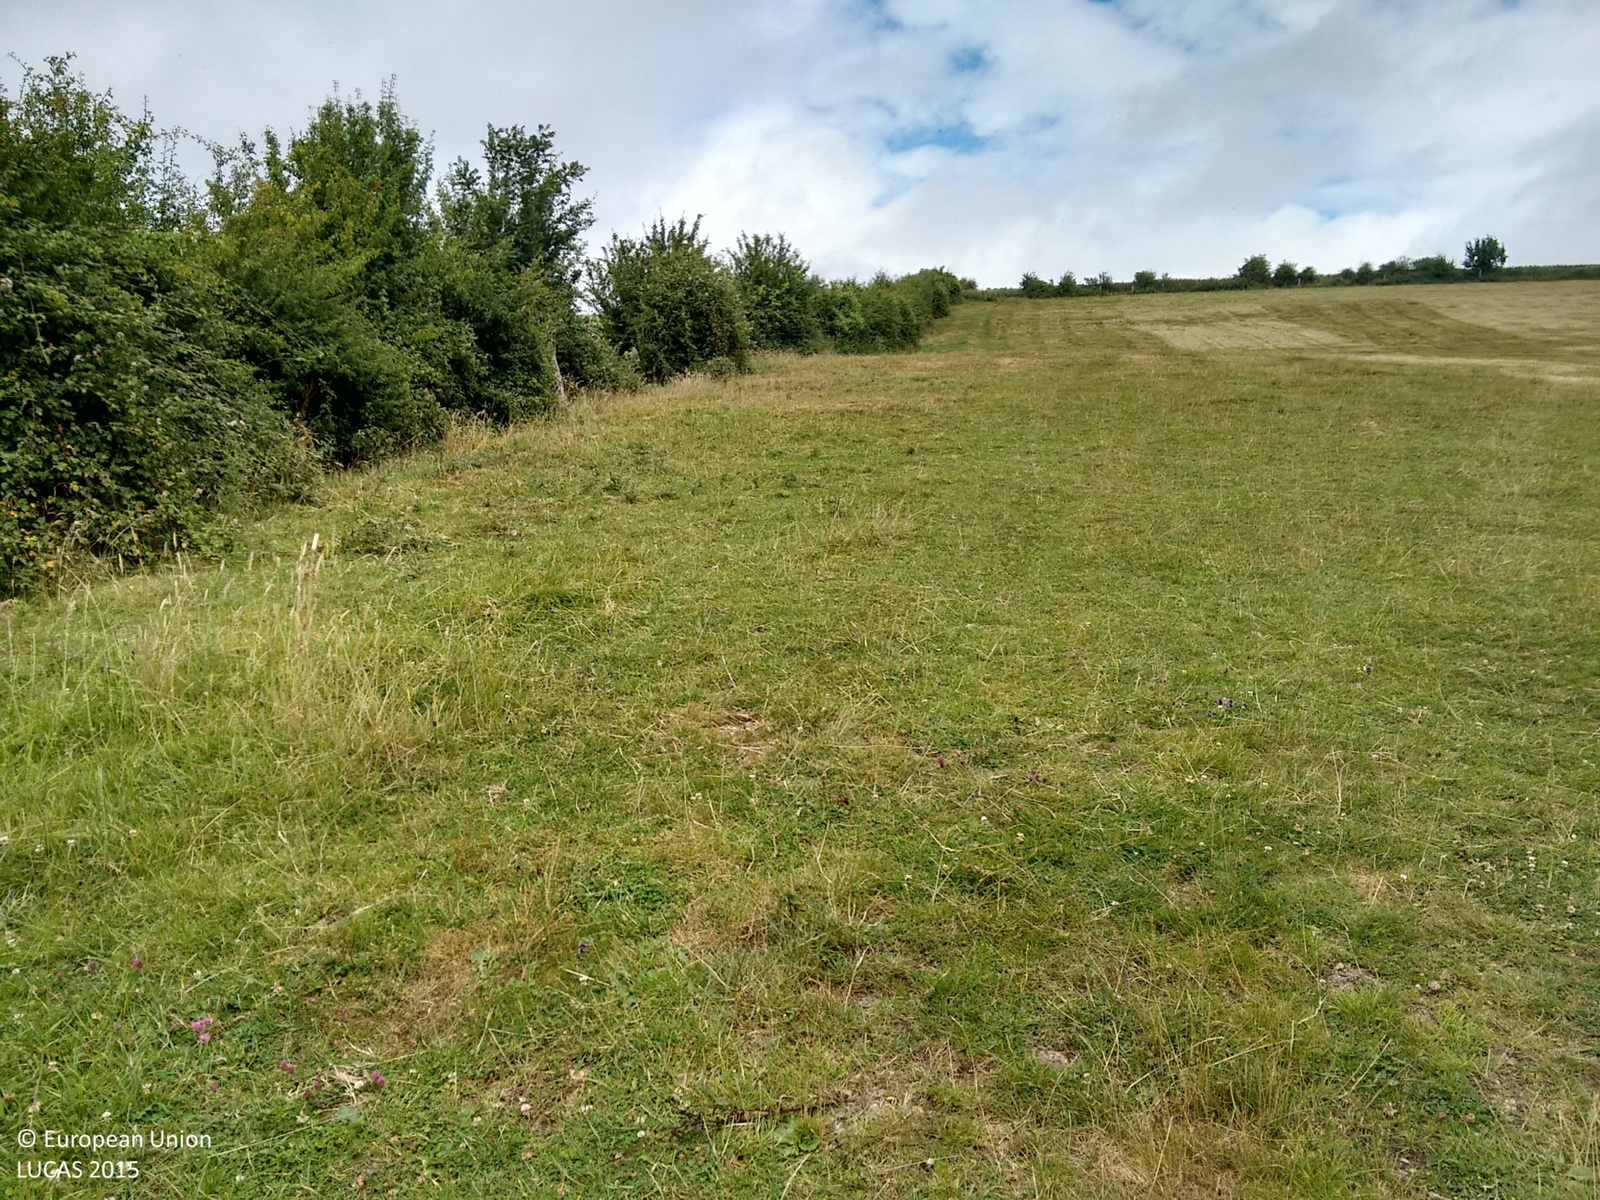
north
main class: Grassland
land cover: Grassland without tree/shrub cover
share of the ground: > 75 %
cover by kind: herbaceous plants 100 %
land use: Agriculture (excluding fallow land and kitchen gardens)
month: July
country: GB
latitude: 51.4576
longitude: -2.3403
